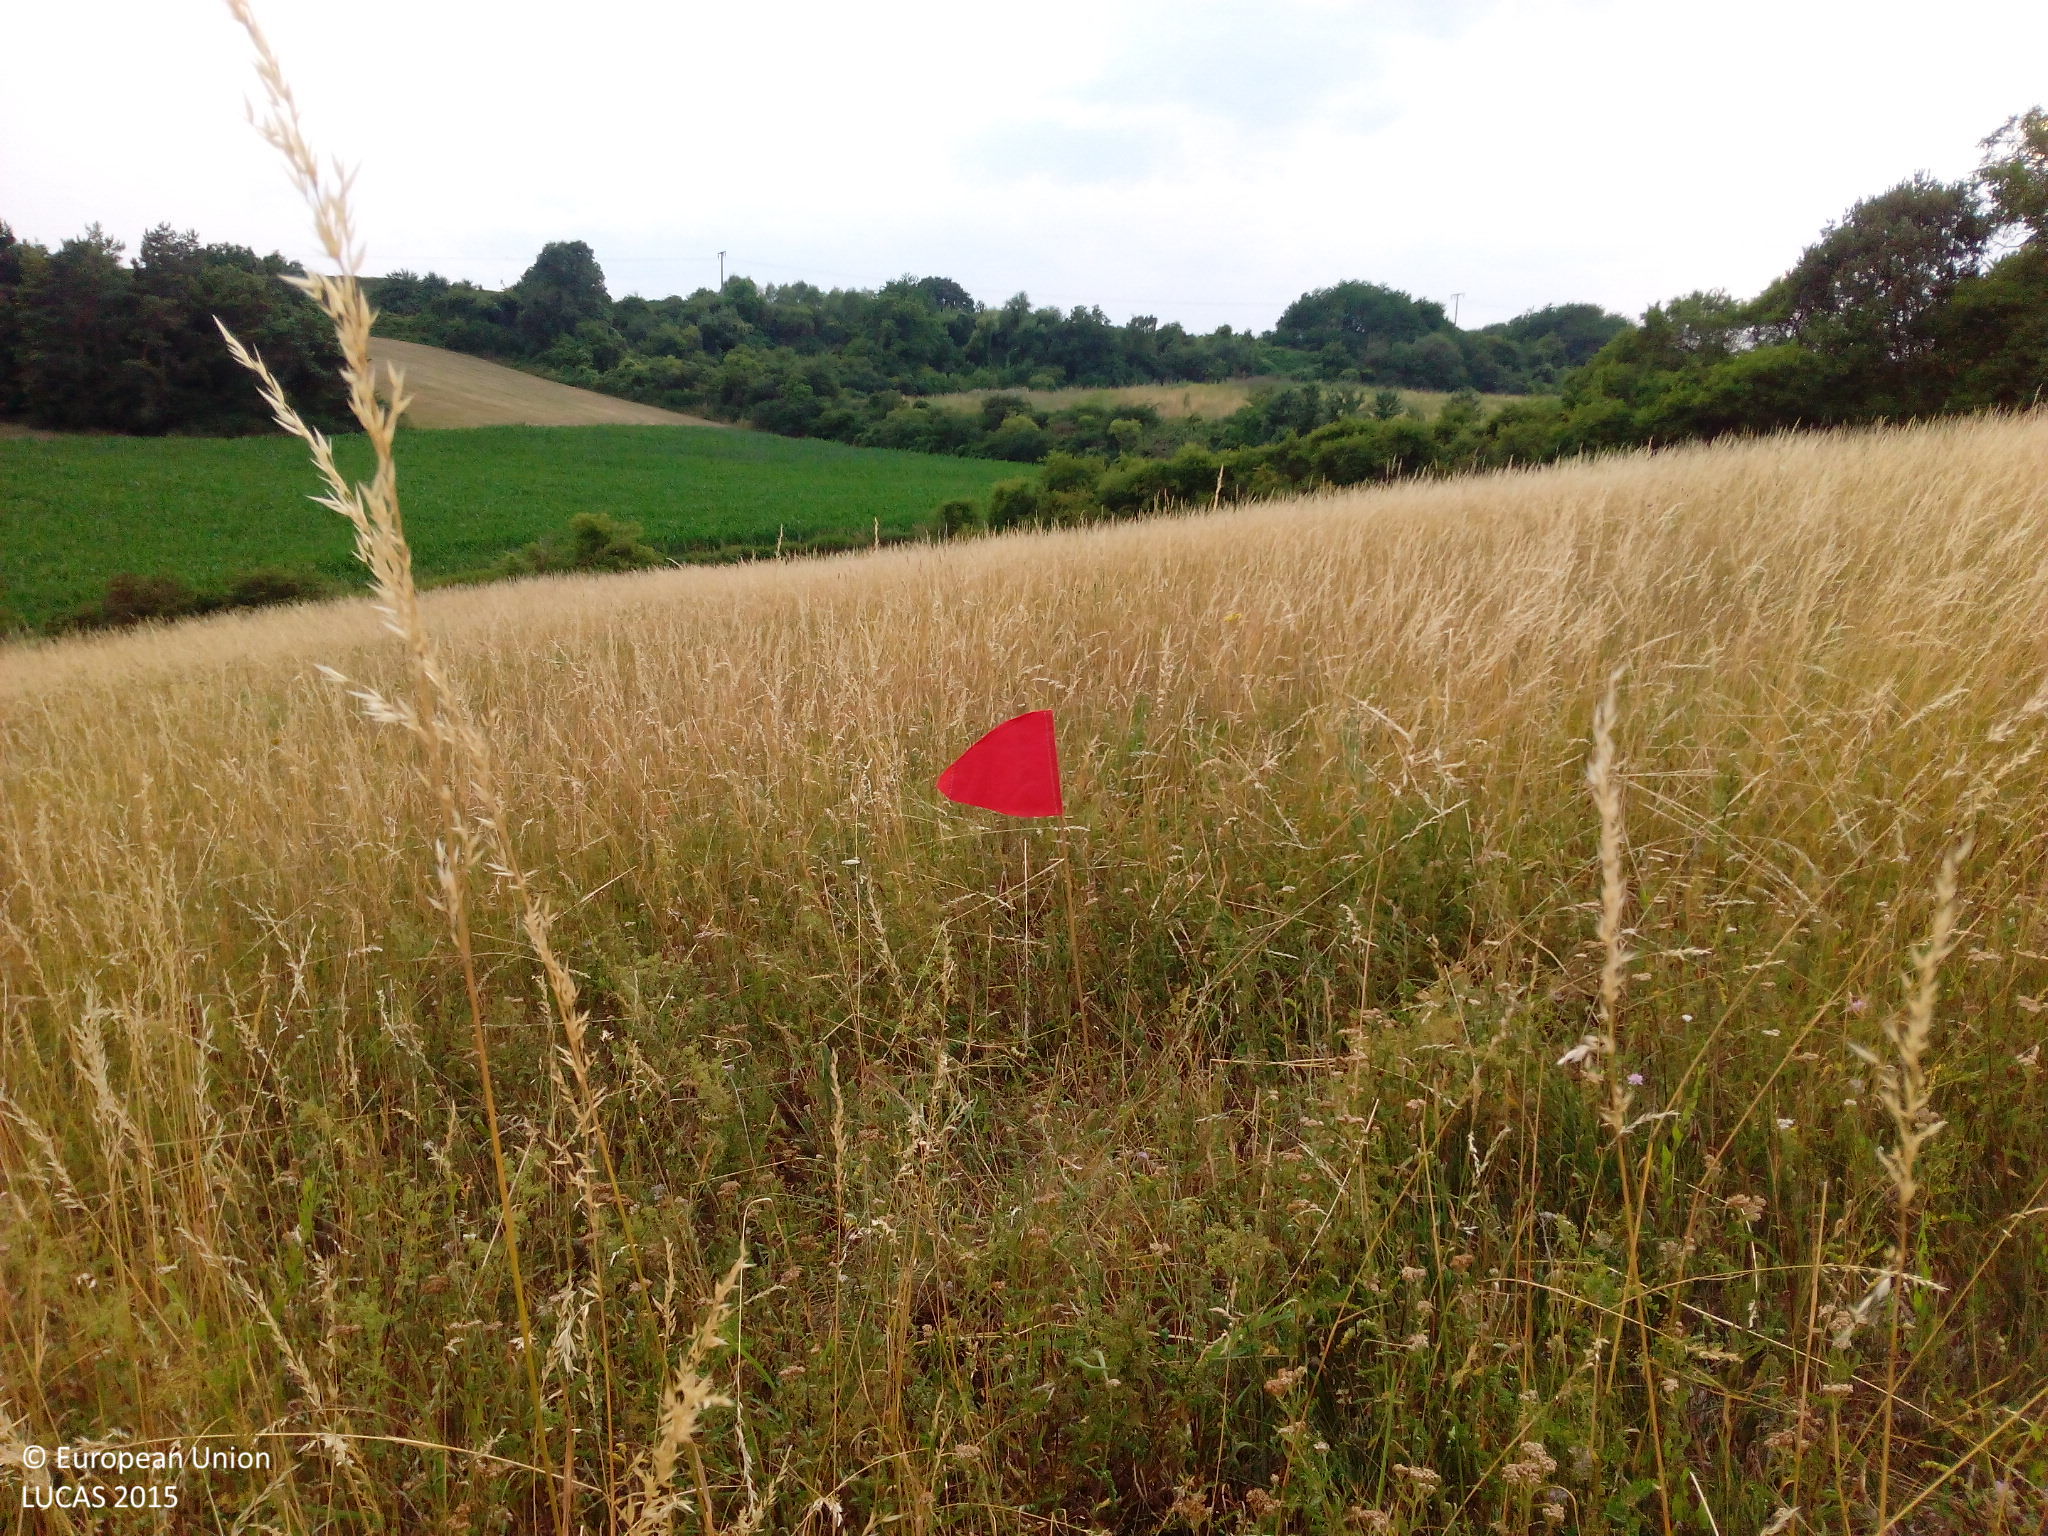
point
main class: Grassland
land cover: Grassland without tree/shrub cover
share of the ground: > 75 %
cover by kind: herbaceous plants 100 %
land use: Agriculture (excluding fallow land and kitchen gardens)
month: July
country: DE
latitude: 49.5188
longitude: 9.9586
